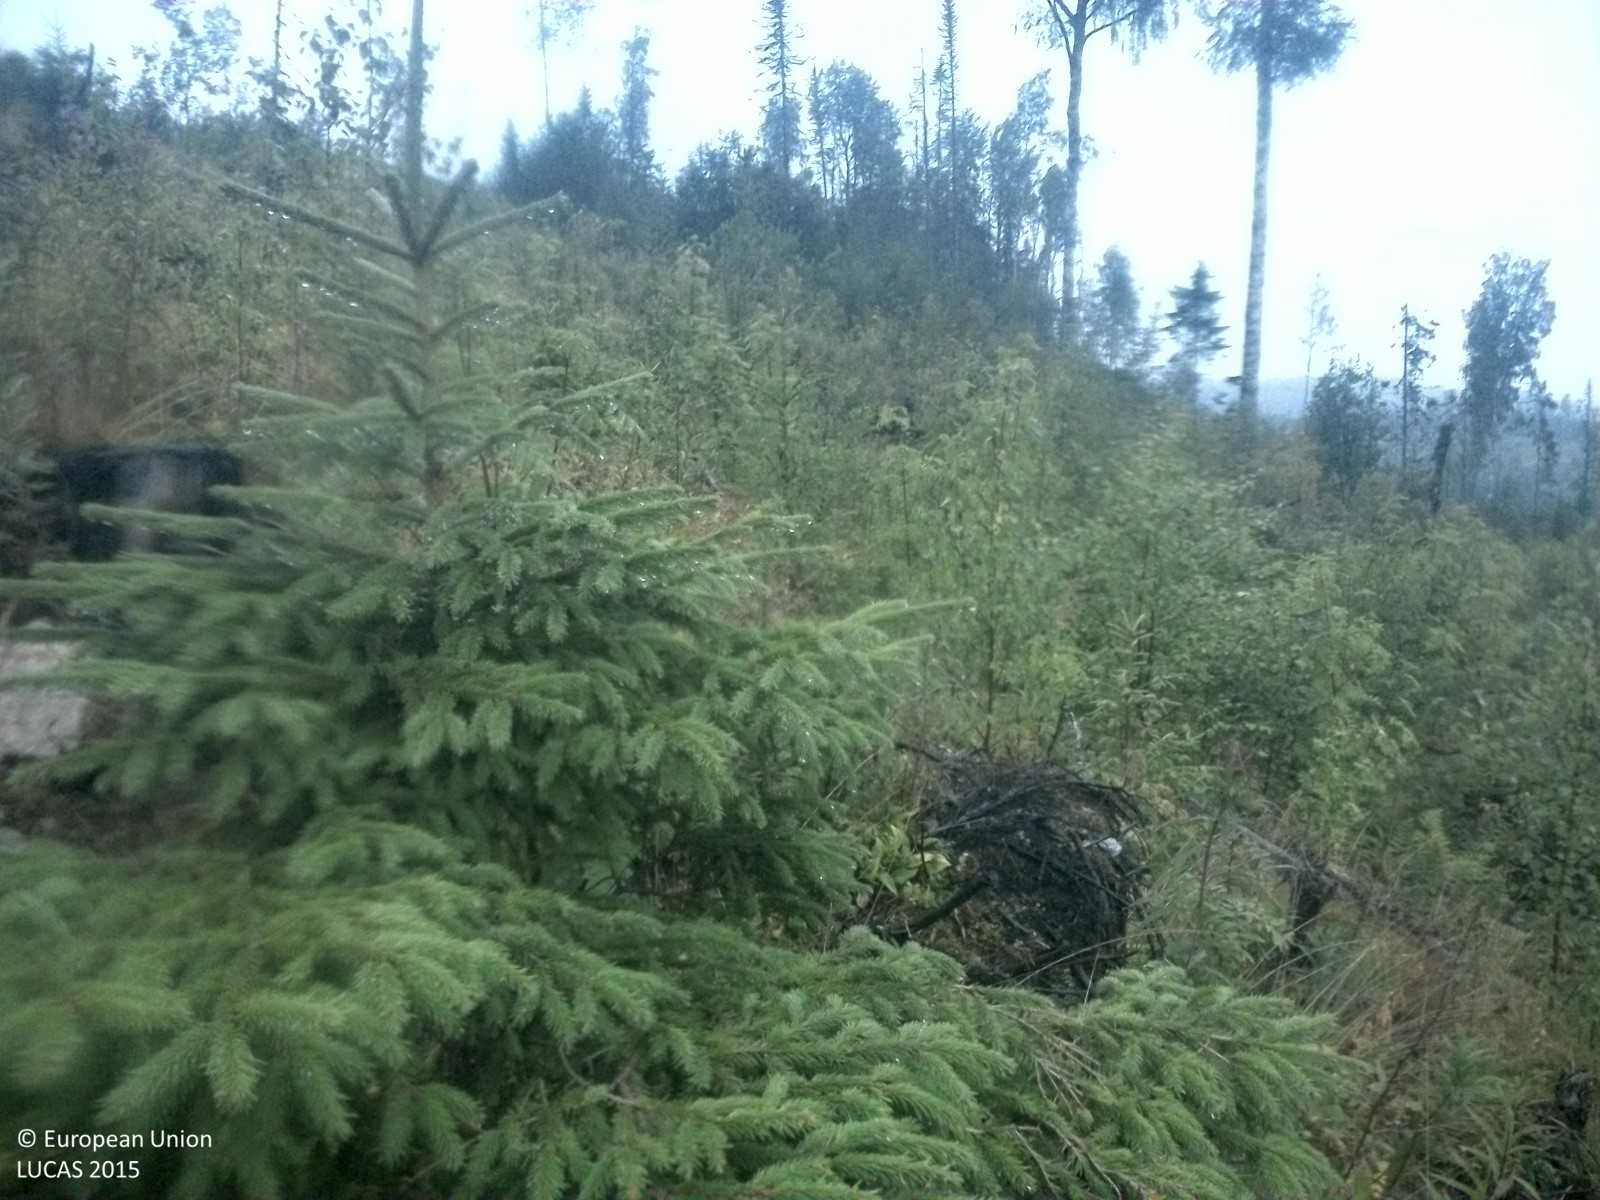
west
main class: Woodland
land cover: Spruce dominated mixed woodland
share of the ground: 10 - 25 %
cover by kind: herbaceous plants 35 %, shrubs 30 %, coniferous forest trees 15 %, consolidated bare surface 10 %, broadleaved forest trees 5 %, unconsolidated bare surface 5 %
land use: Forestry
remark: Clear cut
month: August
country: SE
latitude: 62.3719
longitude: 16.3007
